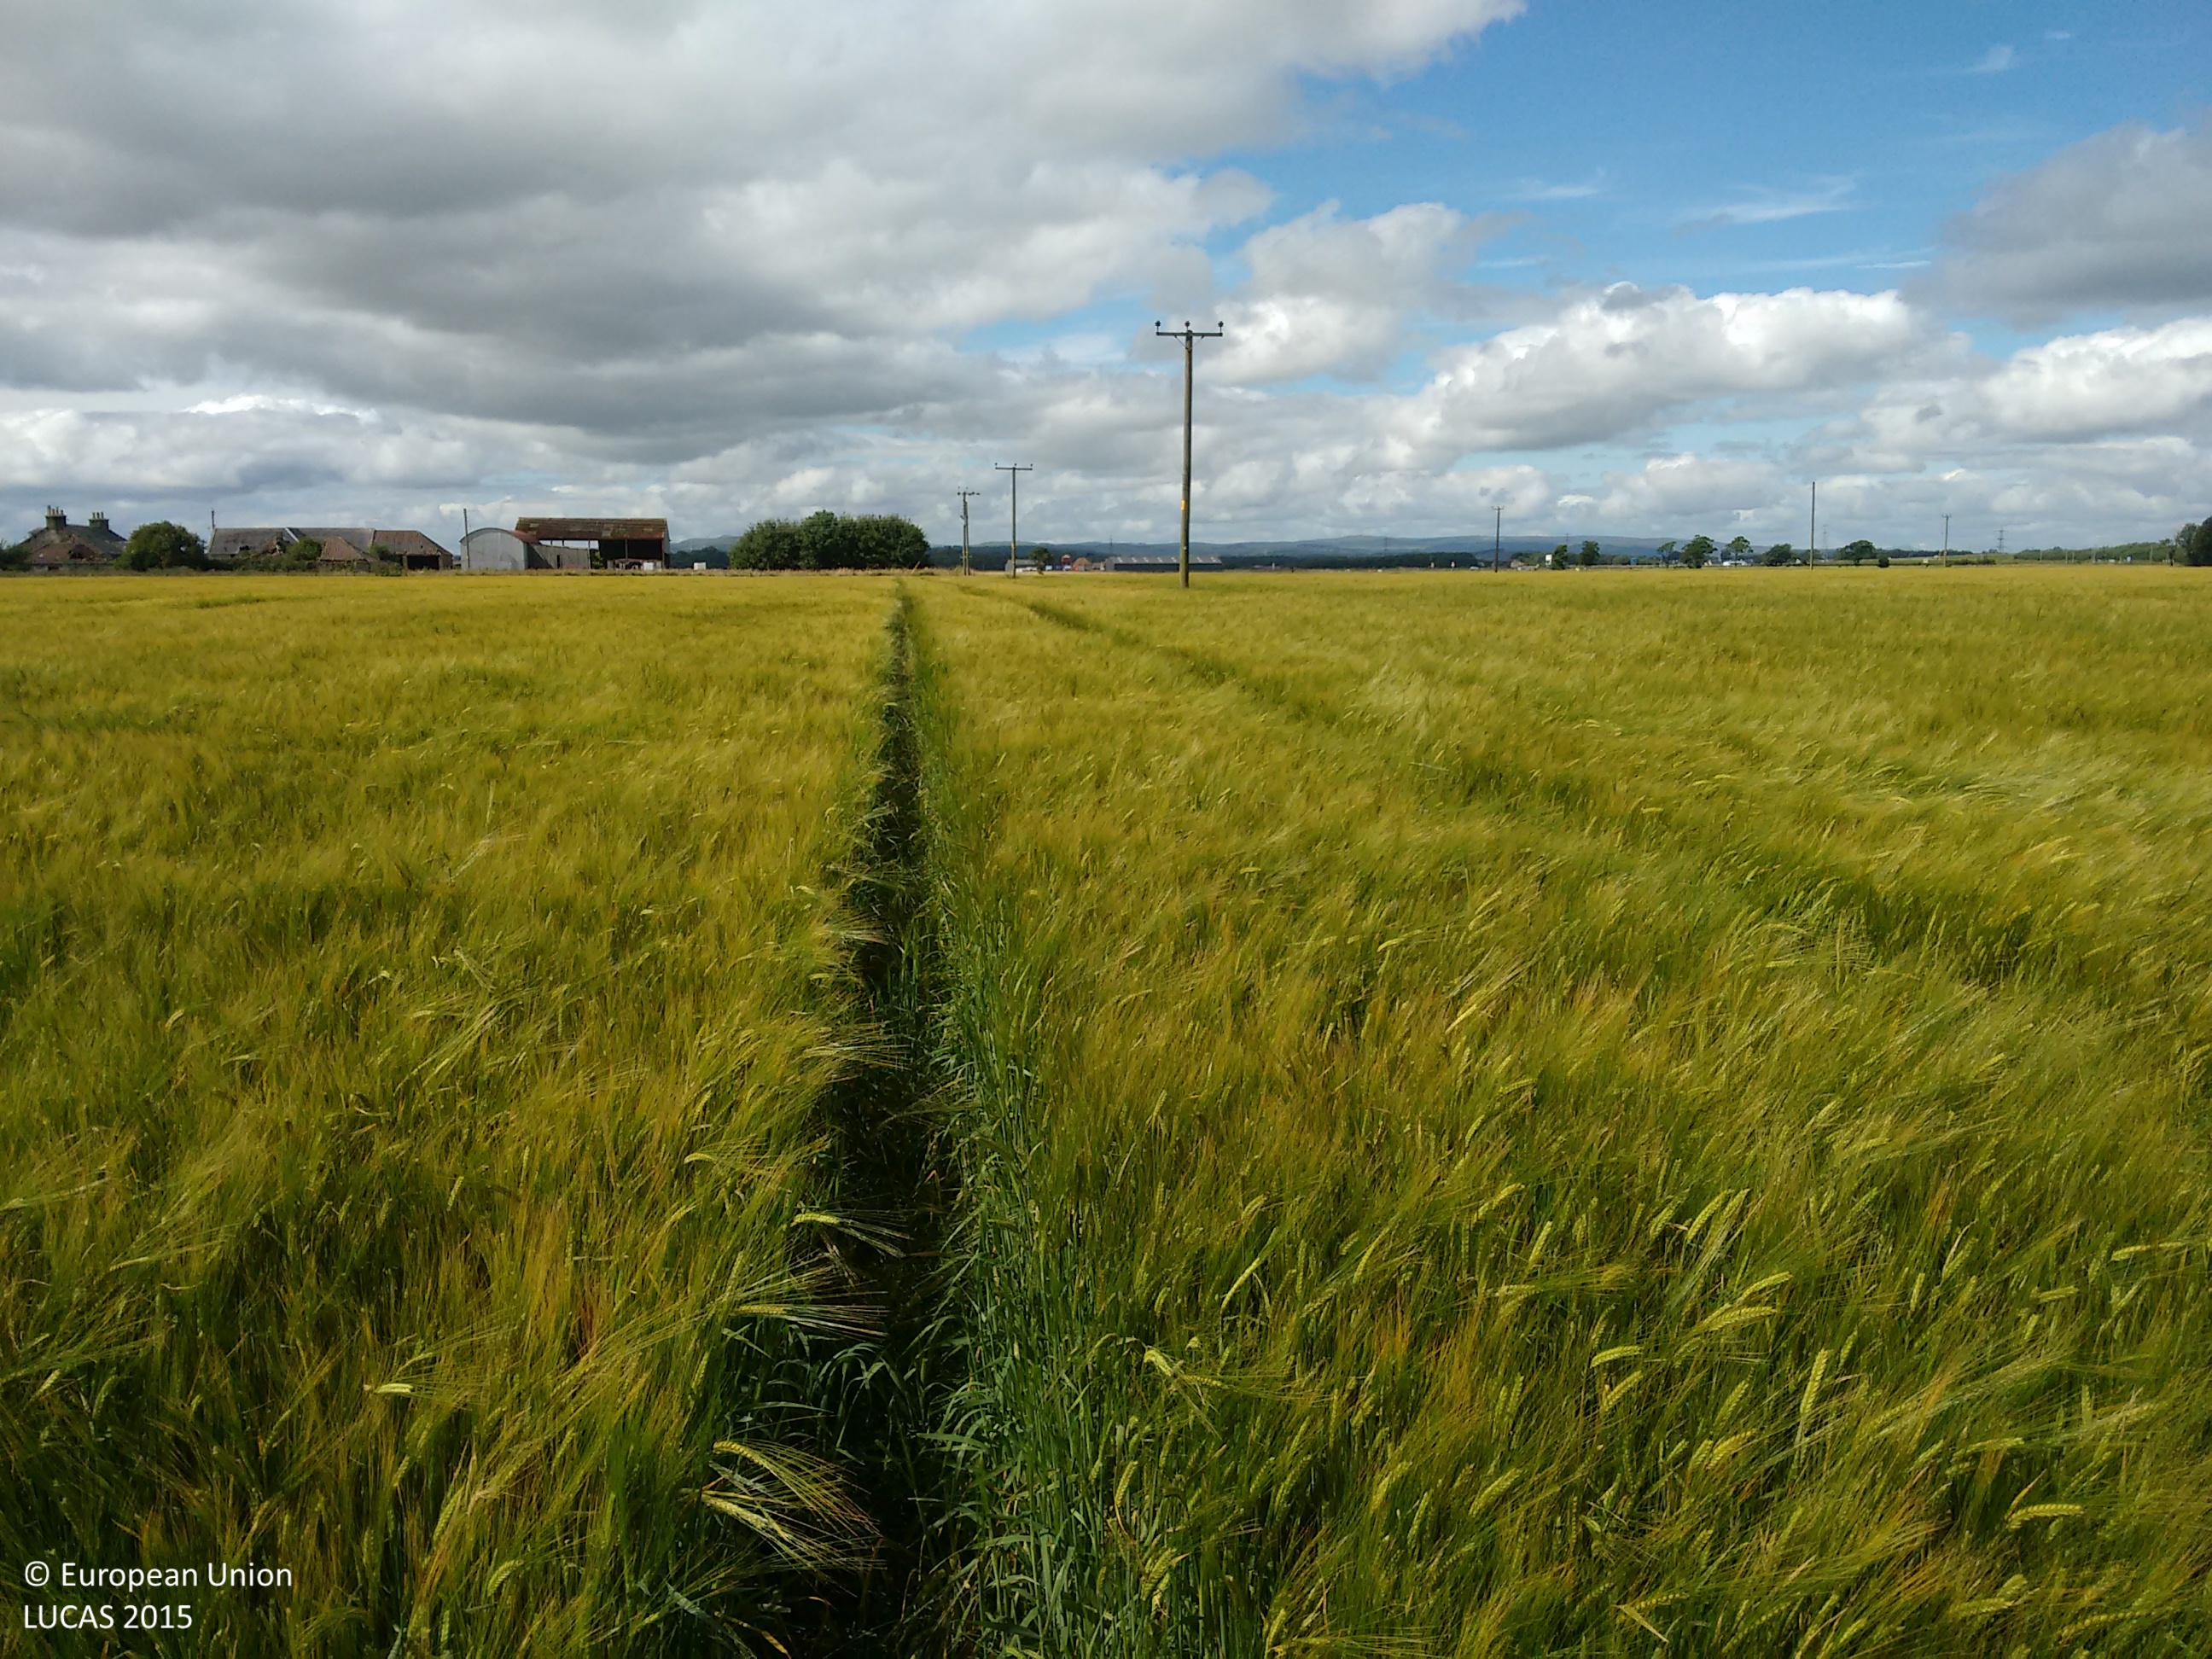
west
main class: Cropland
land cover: Barley
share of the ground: > 75 %
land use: Agriculture (excluding fallow land and kitchen gardens)
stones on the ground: < 10 %
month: August
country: GB
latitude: 56.0463
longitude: -3.7437
